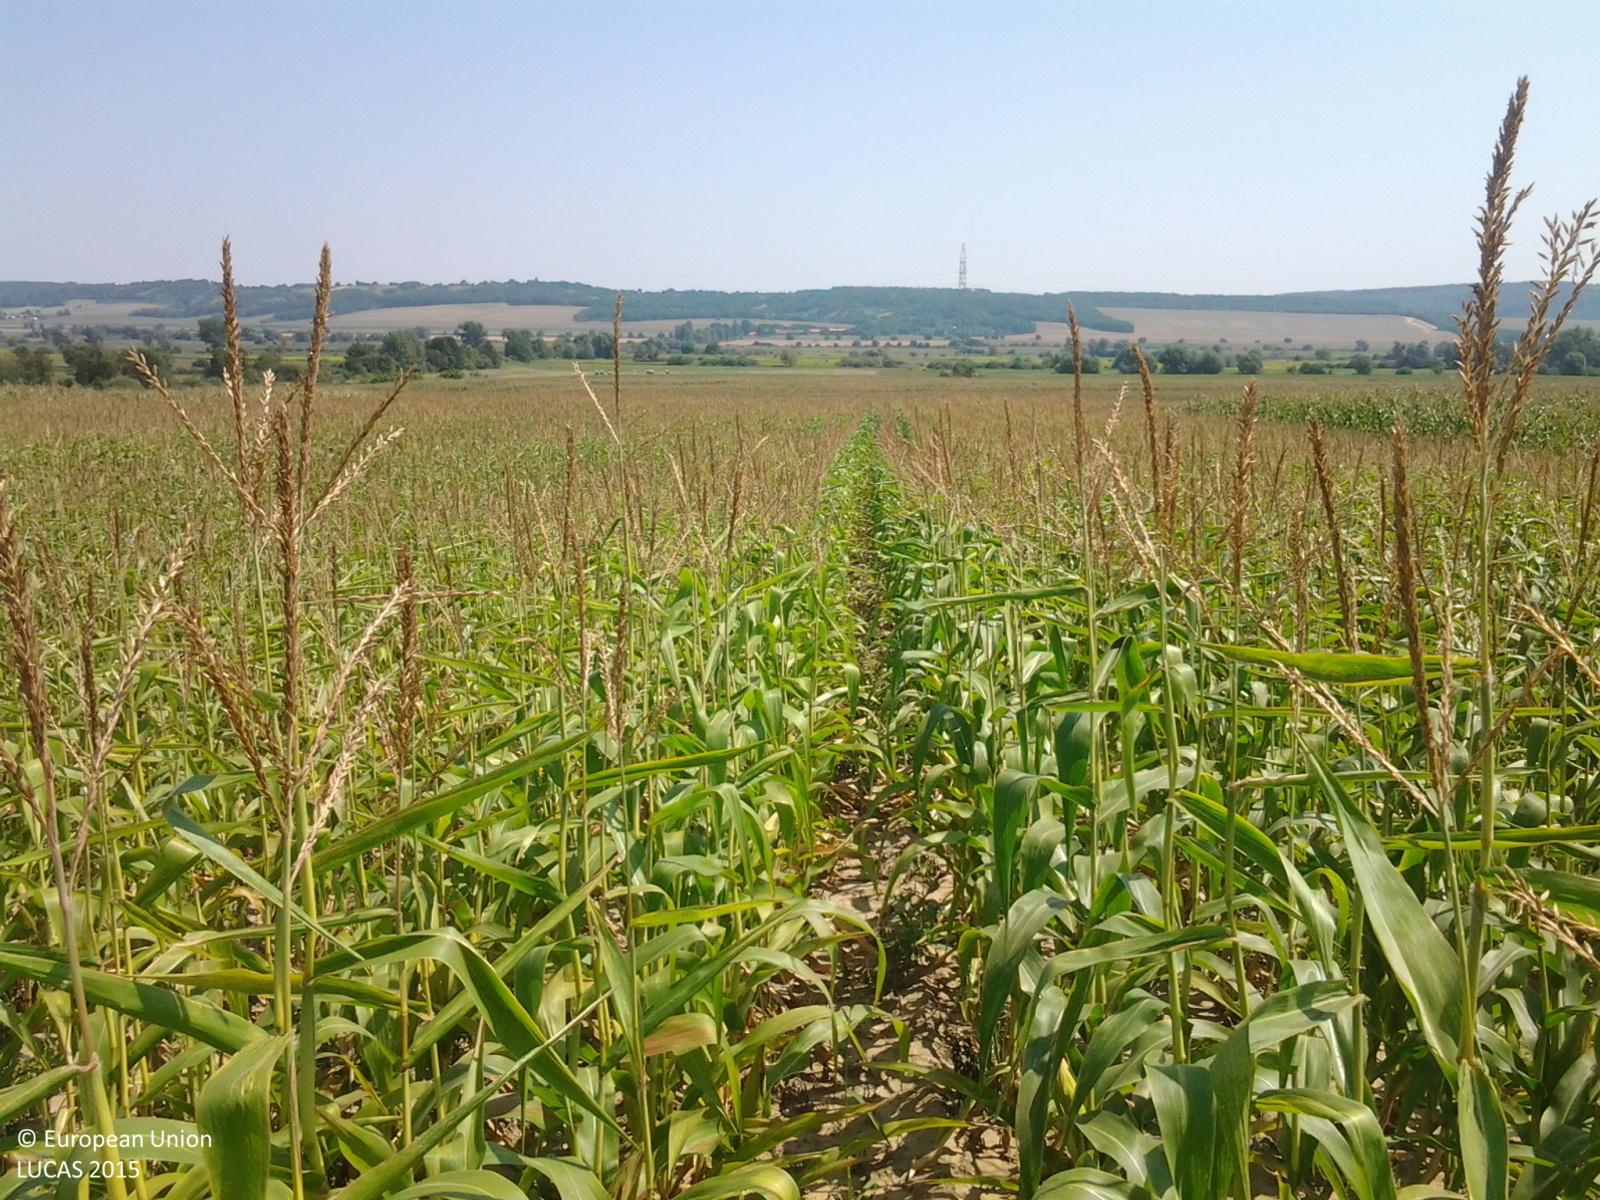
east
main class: Cropland
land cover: Maize
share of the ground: > 75 %
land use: Agriculture (excluding fallow land and kitchen gardens)
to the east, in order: Maize; Tracks; Maize
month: August
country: HU
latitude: 46.5764
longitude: 16.9578
